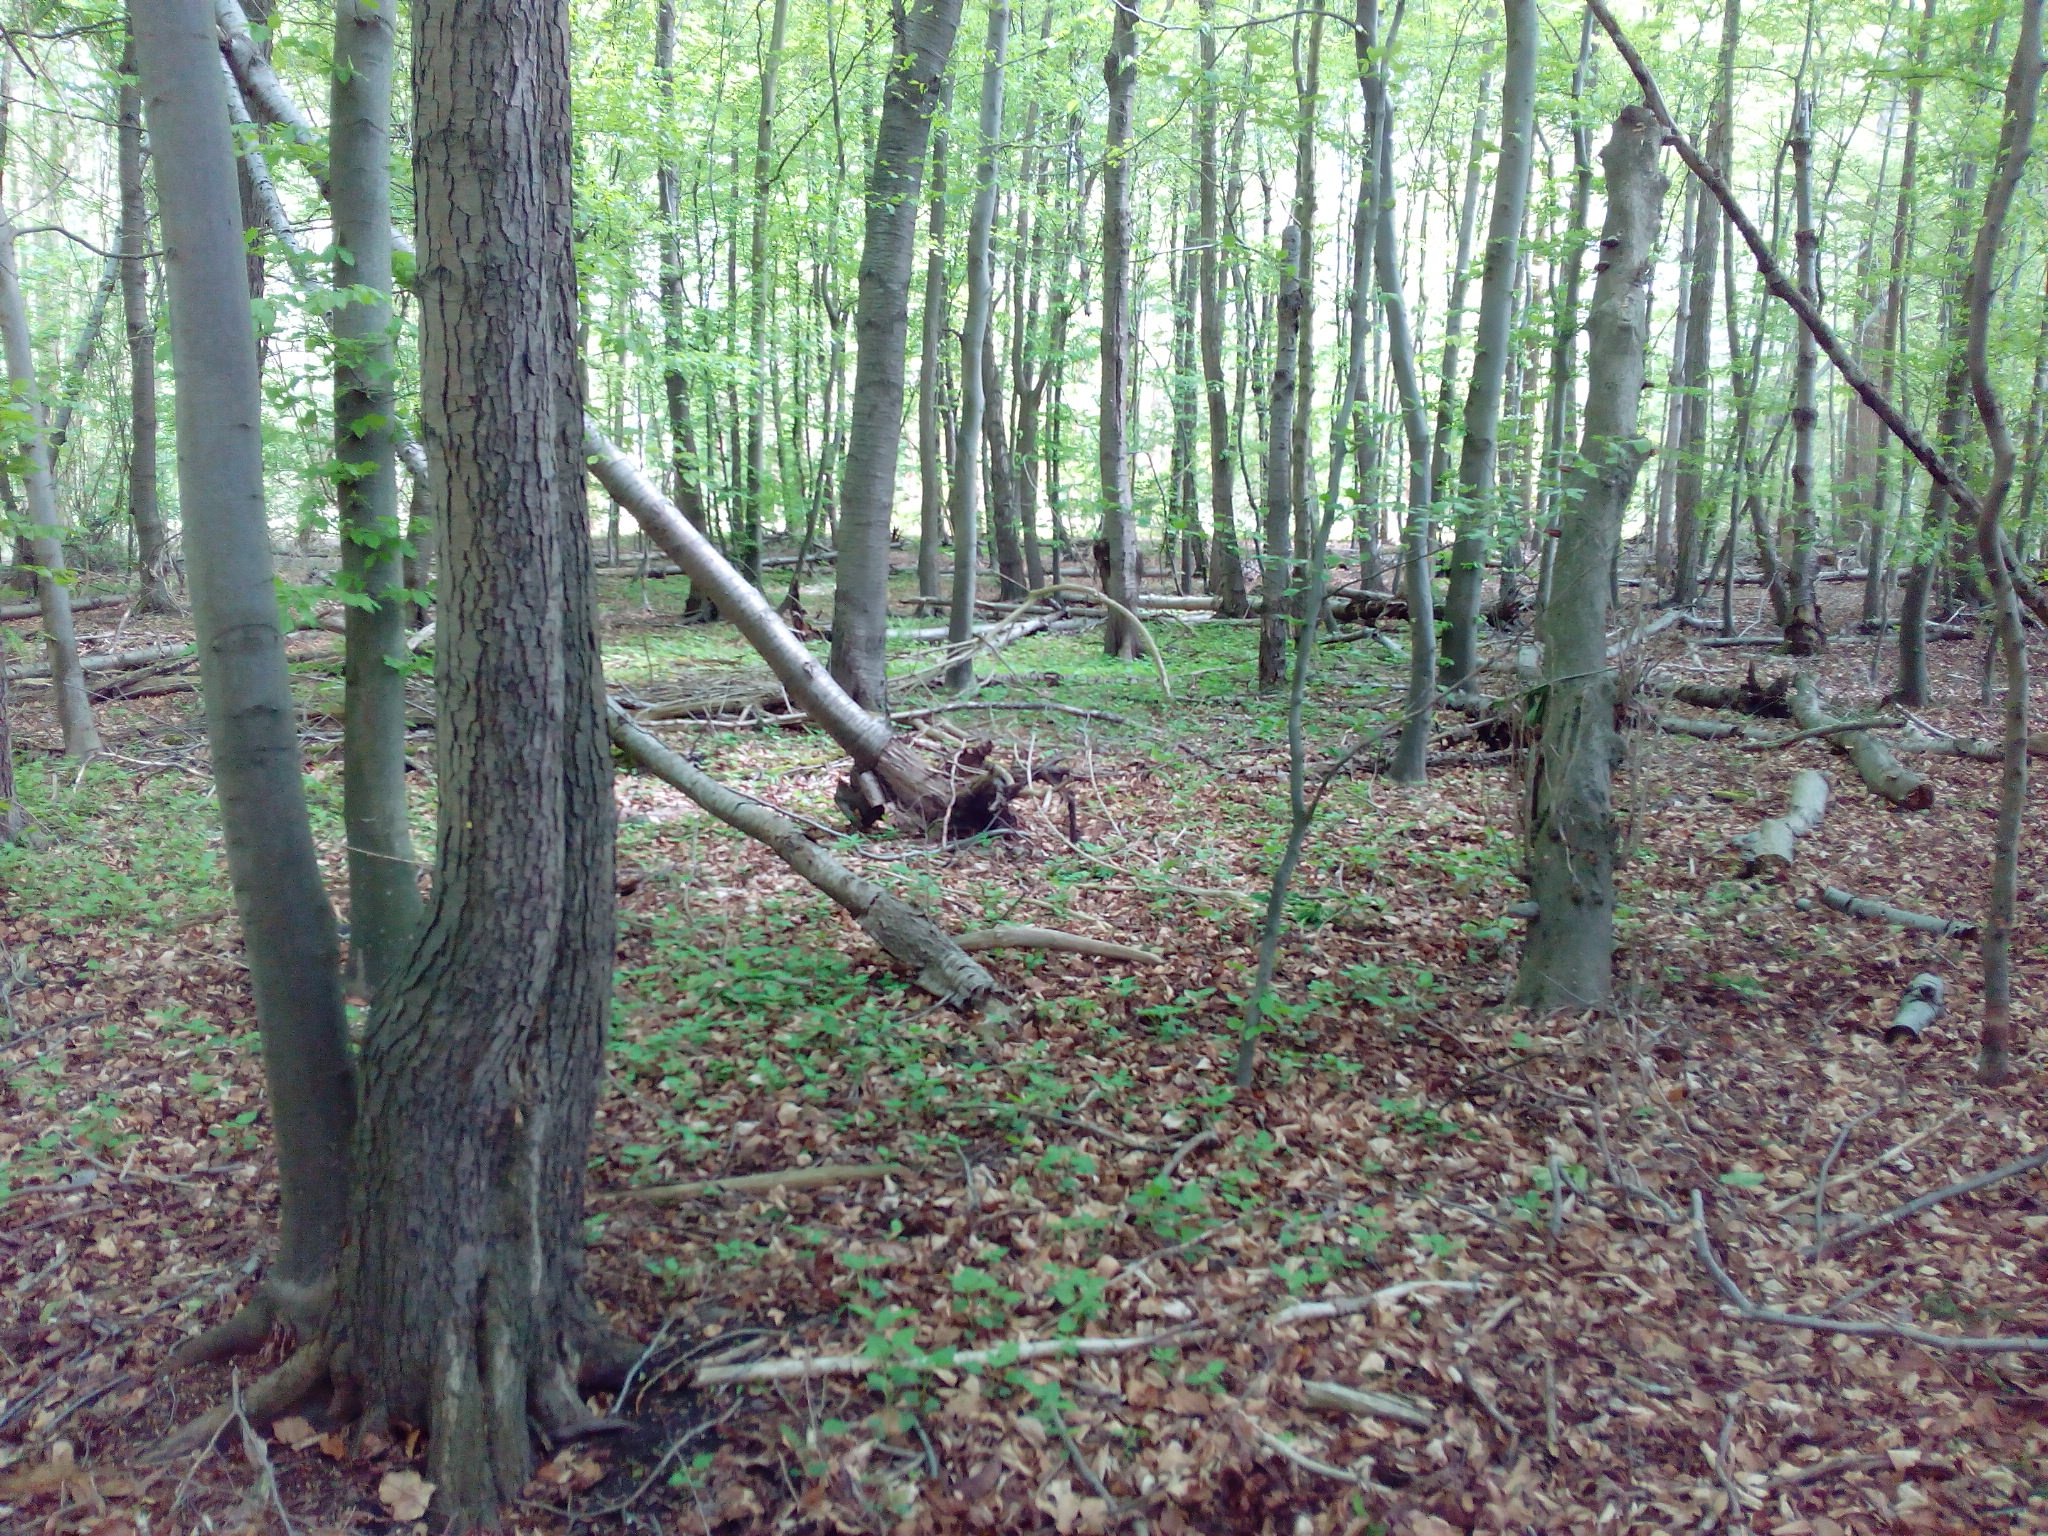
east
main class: Woodland
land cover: Broadleaved woodland
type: beech forest
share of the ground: > 75 %
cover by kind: broadleaved forest trees 95 %, herbaceous plants 5 %
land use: Forestry
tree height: > 5 m
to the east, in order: Broadleaved woodland; Spontaneously vegetated surfaces
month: May
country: DE
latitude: 52.3954
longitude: 9.8678
